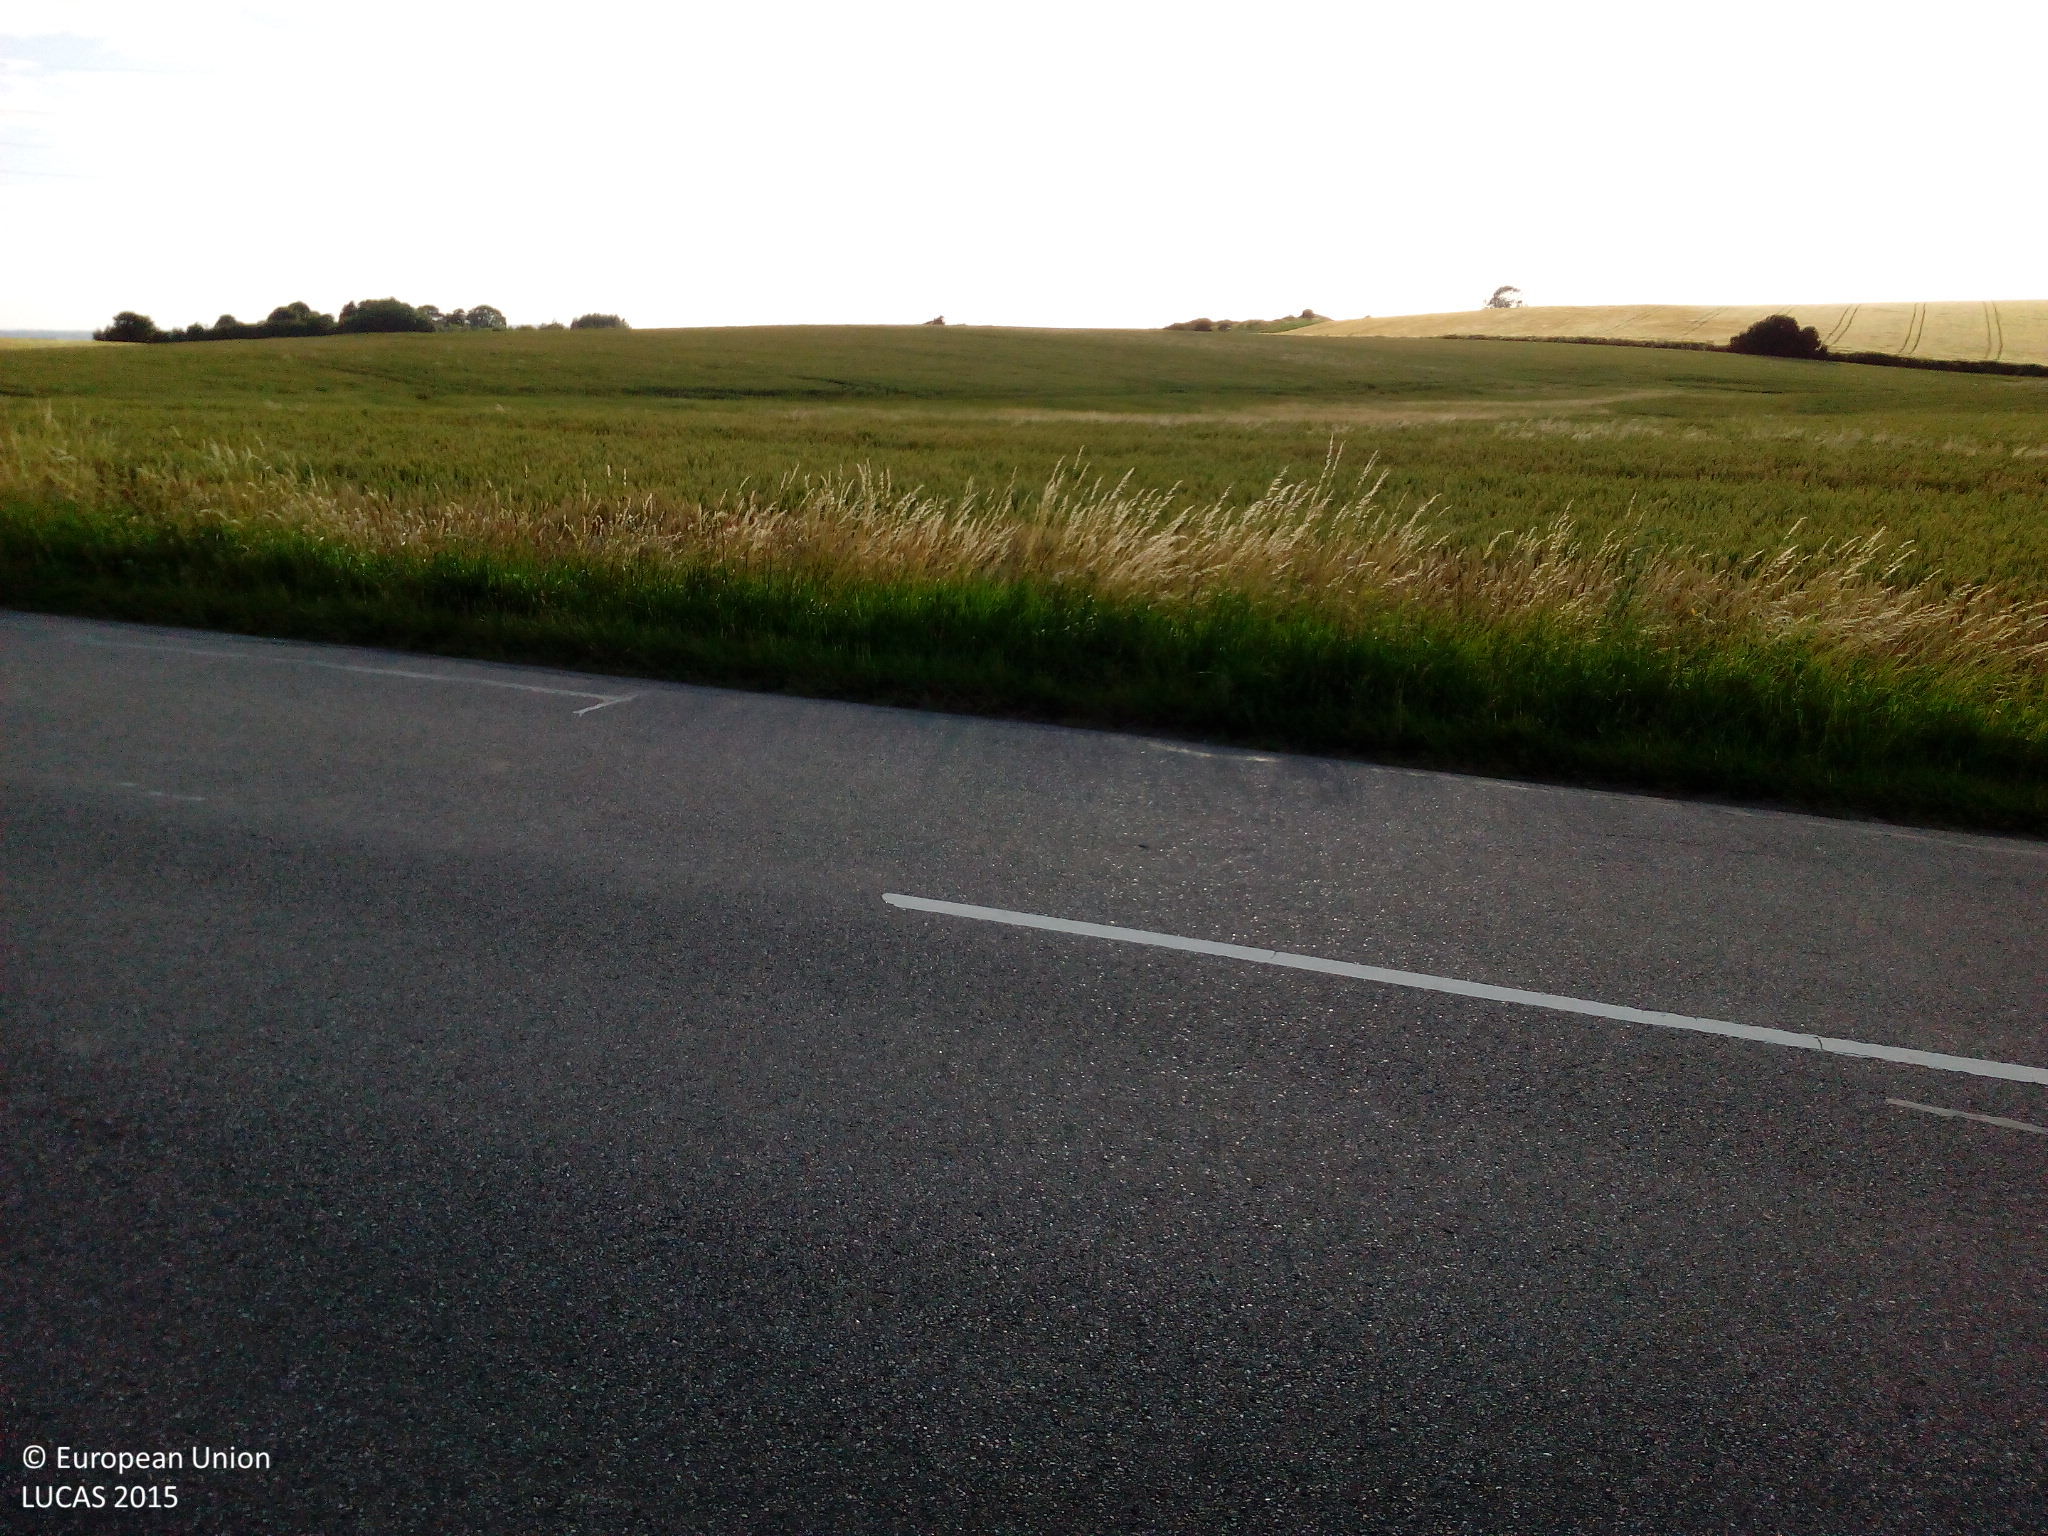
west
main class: Cropland
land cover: Common wheat
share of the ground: > 75 %
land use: Agriculture (excluding fallow land and kitchen gardens)
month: July
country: DK
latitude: 55.8189
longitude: 11.5466
